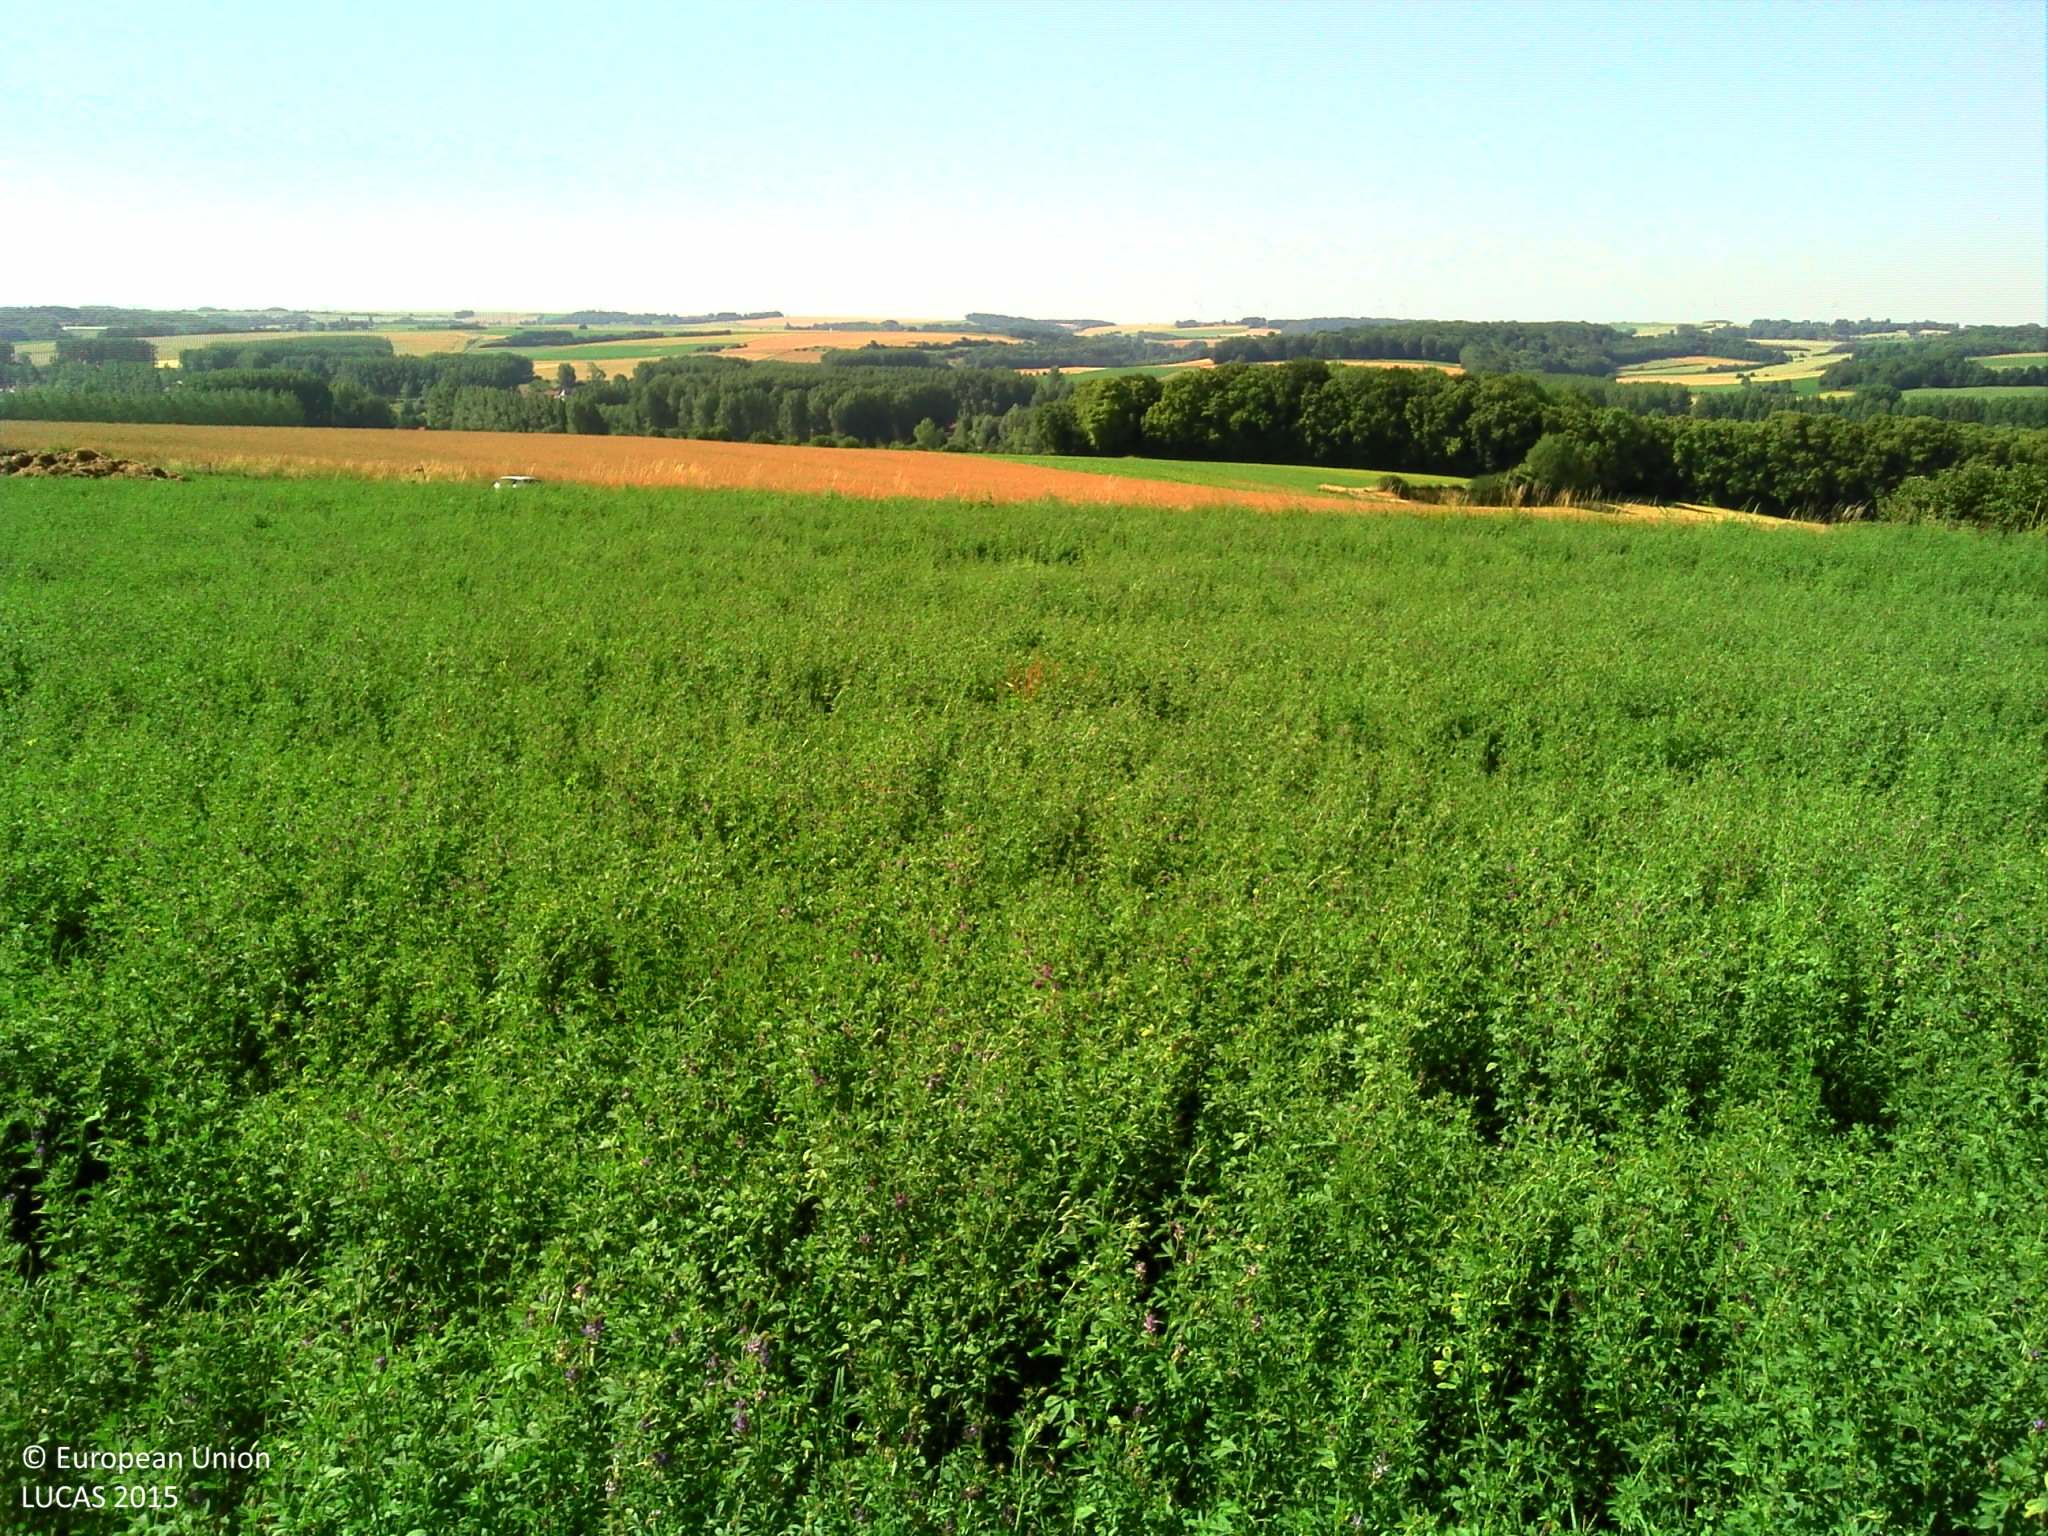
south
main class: Cropland
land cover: Lucerne
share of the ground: > 75 %
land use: Agriculture (excluding fallow land and kitchen gardens)
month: July
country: FR
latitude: 50.2225
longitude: 2.1786
